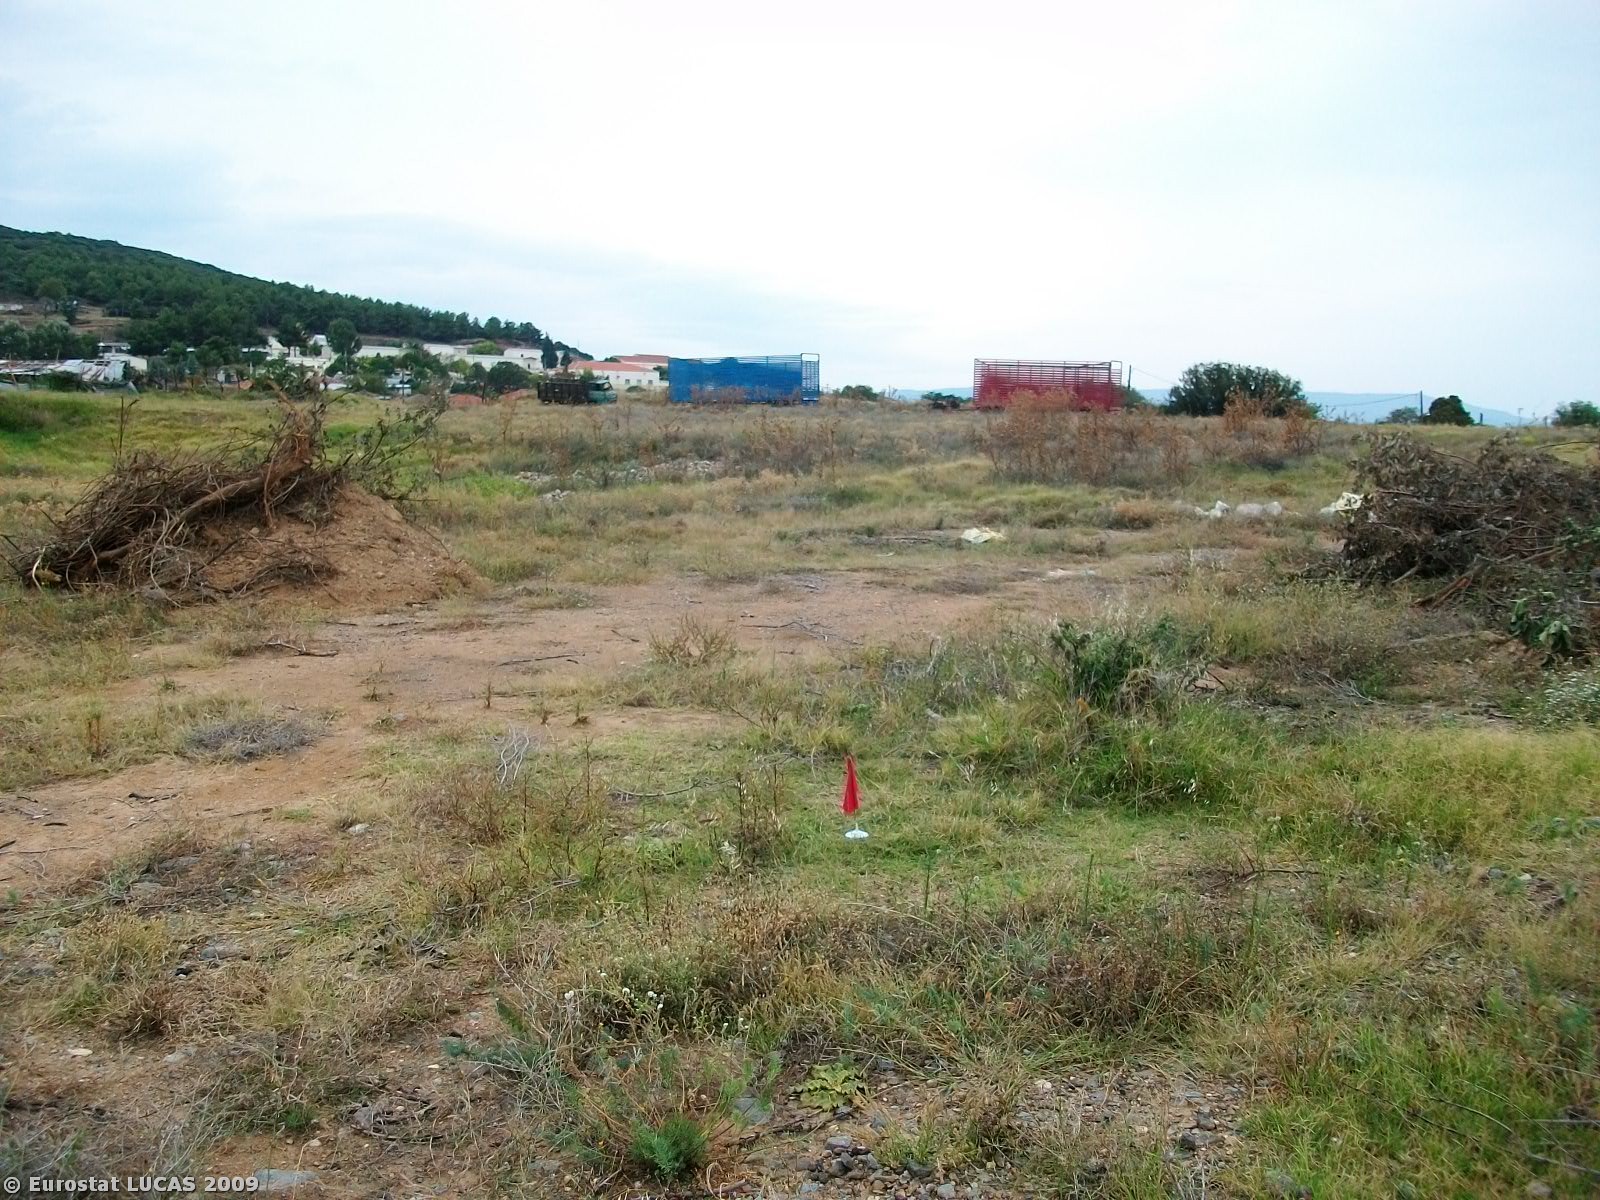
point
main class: Grassland
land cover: Grassland without tree/shrub cover
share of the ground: 50 - 75 %
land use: Agriculture (excluding fallow land and kitchen gardens)
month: September
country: GR
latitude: 40.8957
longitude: 23.5614
